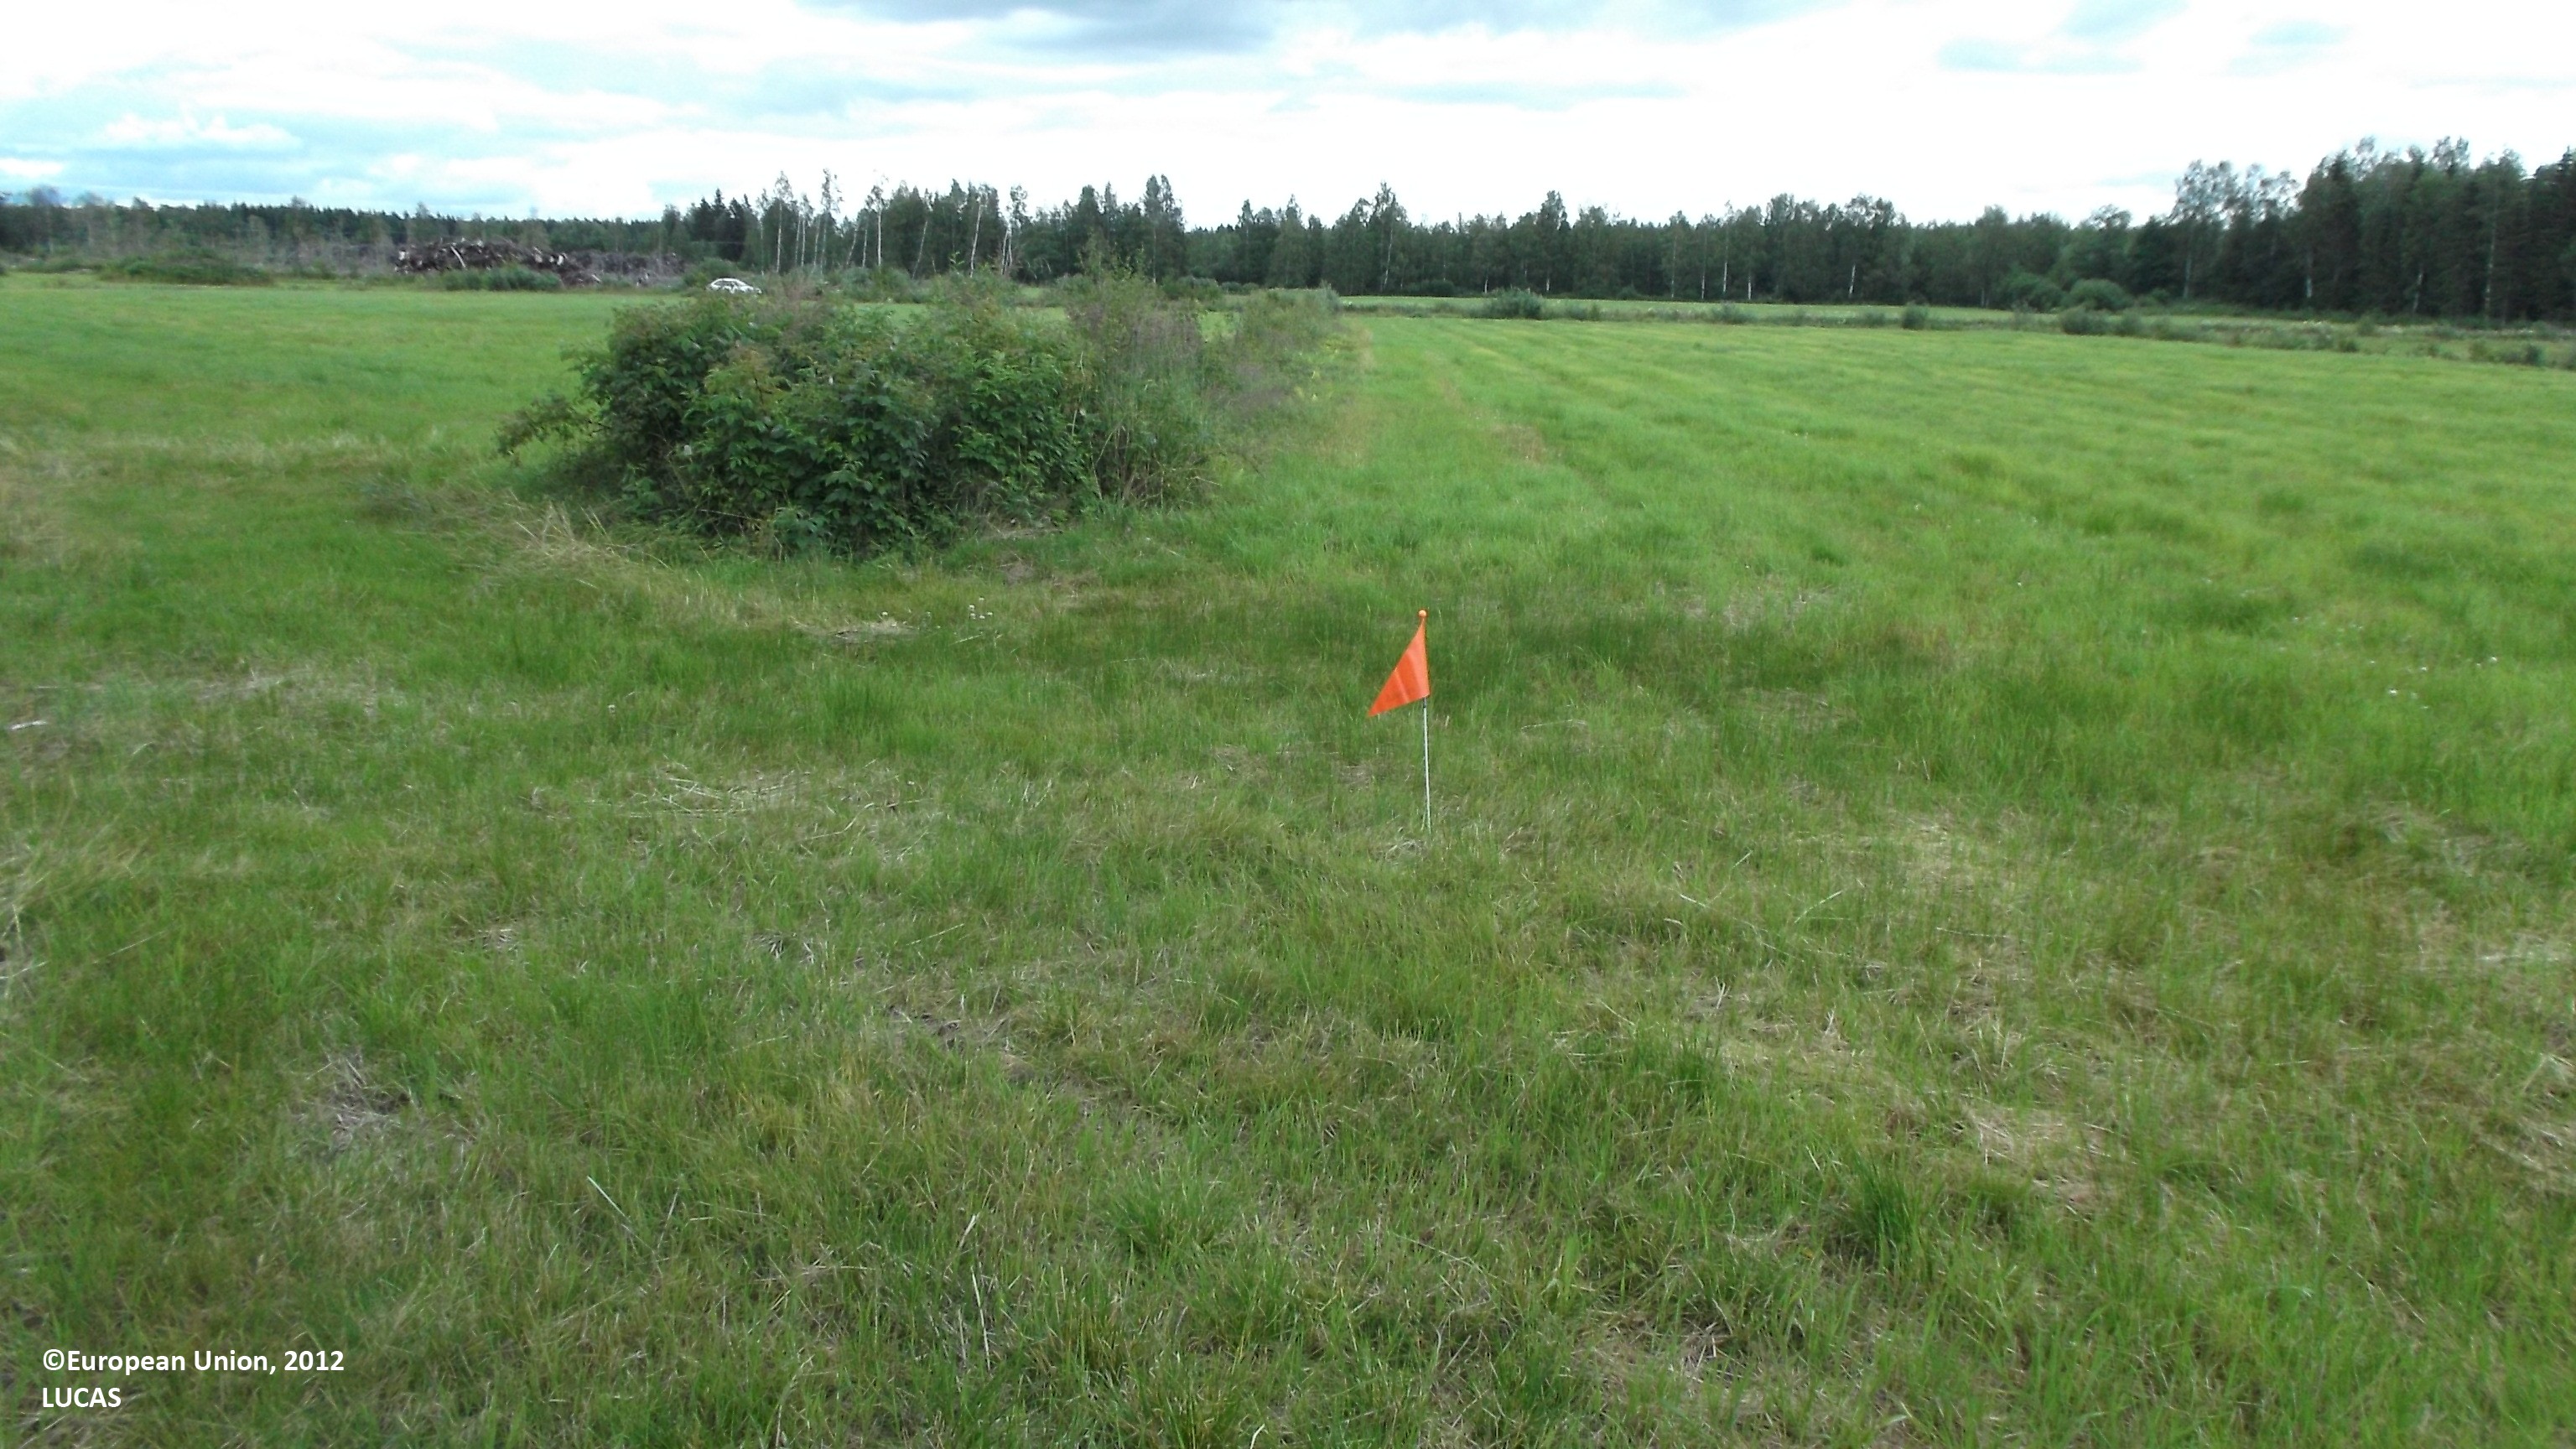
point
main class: Cropland
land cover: Temporary grasslands
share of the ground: > 75 %
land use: Agriculture (excluding fallow land and kitchen gardens)
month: July
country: FI
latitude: 63.6774
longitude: 23.2145
